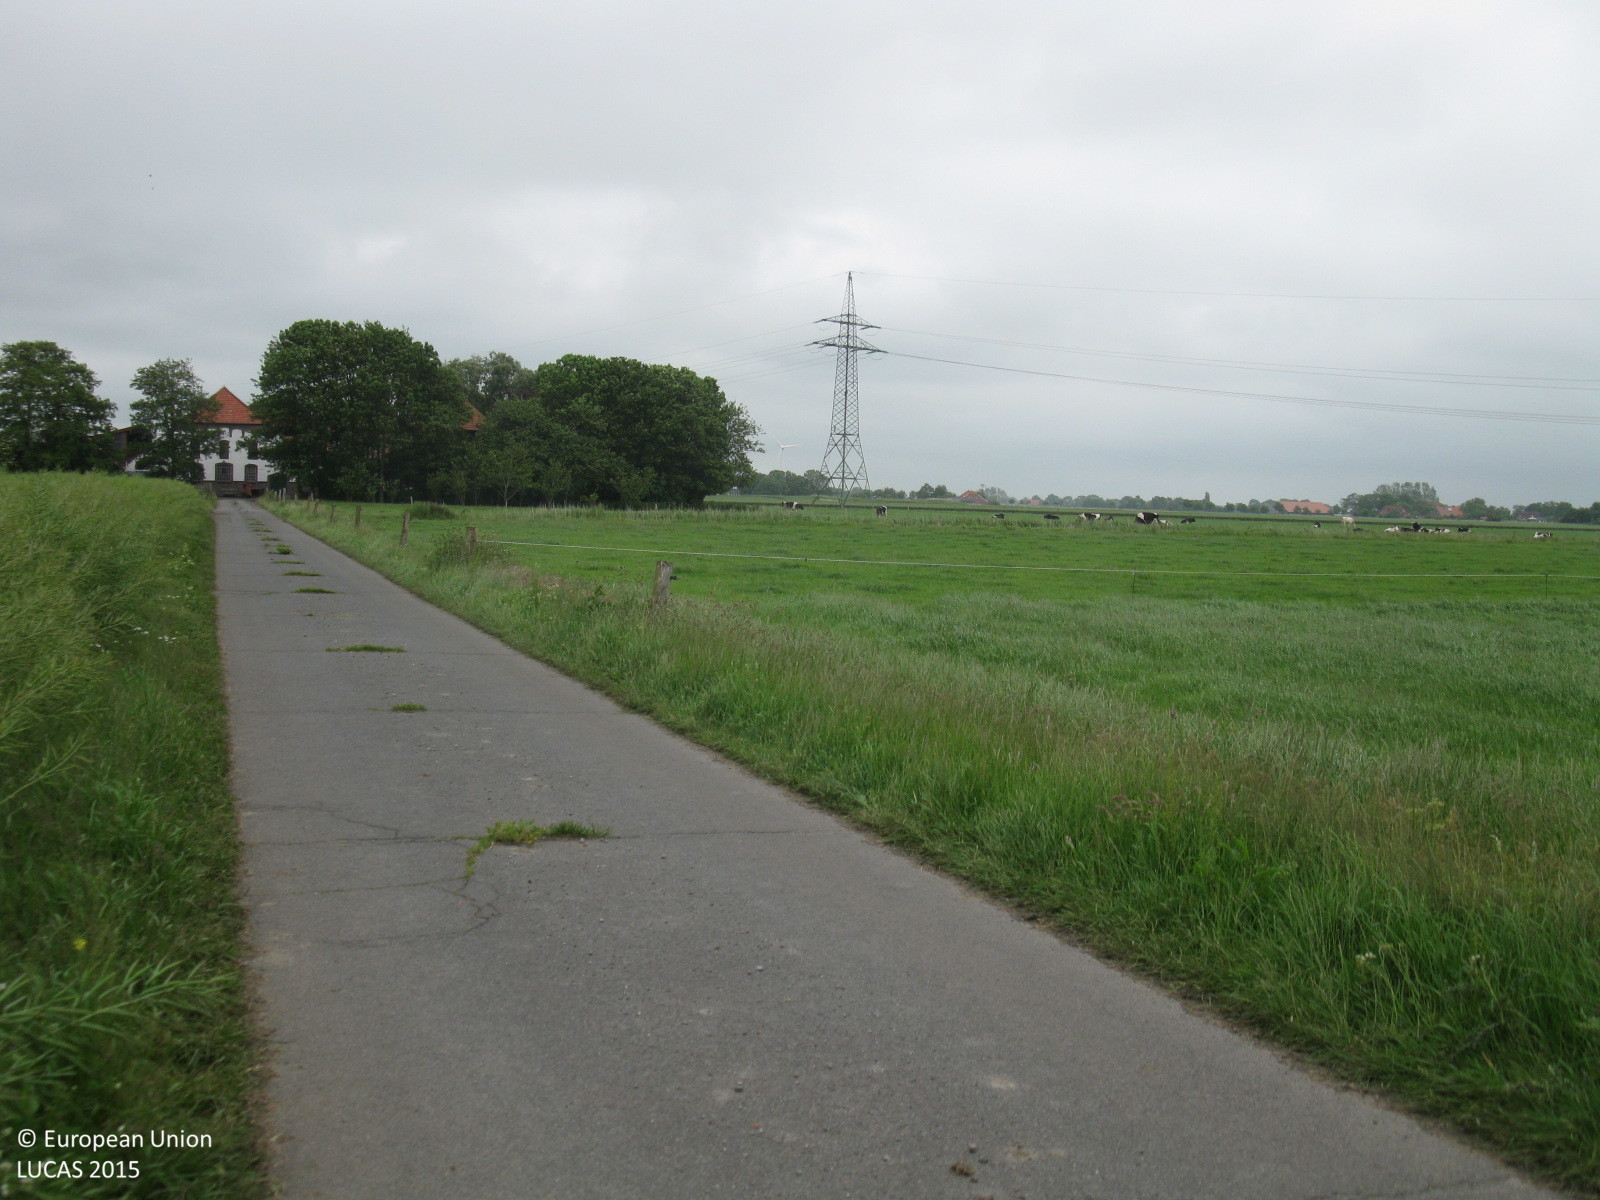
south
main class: Cropland
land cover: Rape and turnip rape
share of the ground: > 75 %
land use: Agriculture (excluding fallow land and kitchen gardens)
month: June
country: DE
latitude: 53.6708
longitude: 7.8665
